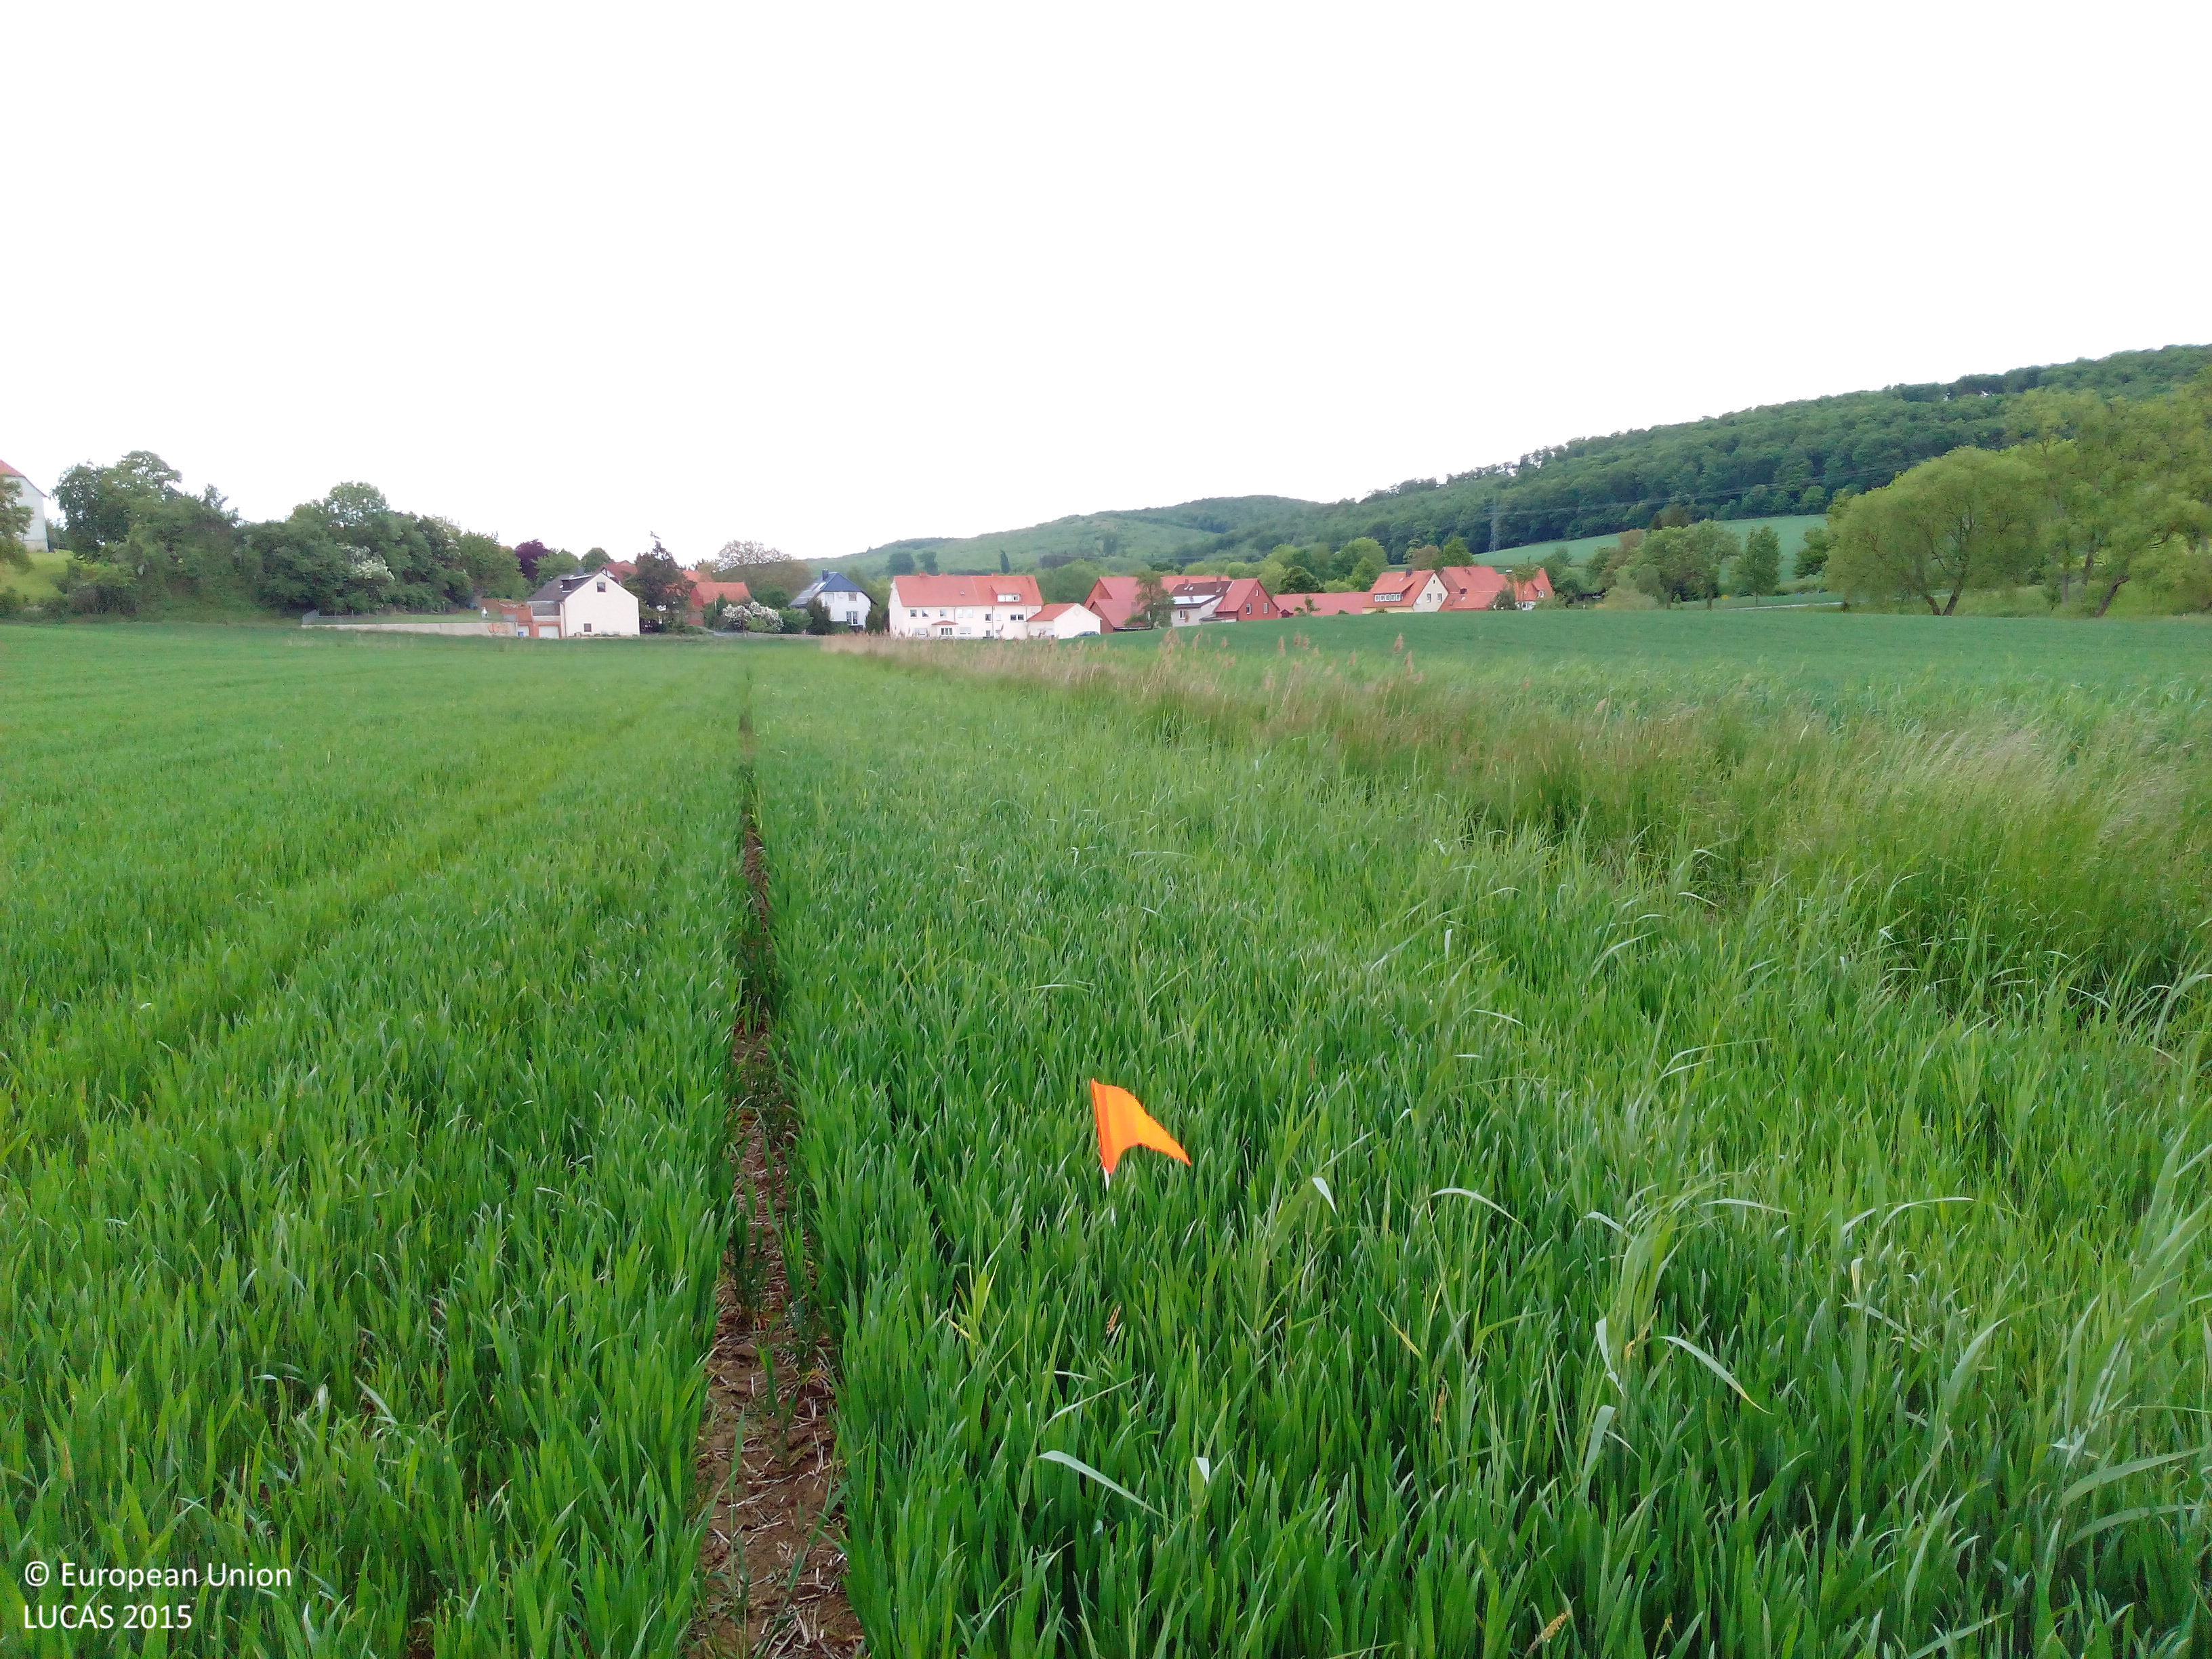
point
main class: Cropland
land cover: Common wheat
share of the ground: > 75 %
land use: Agriculture (excluding fallow land and kitchen gardens)
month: May
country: DE
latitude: 52.0718
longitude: 9.8687
